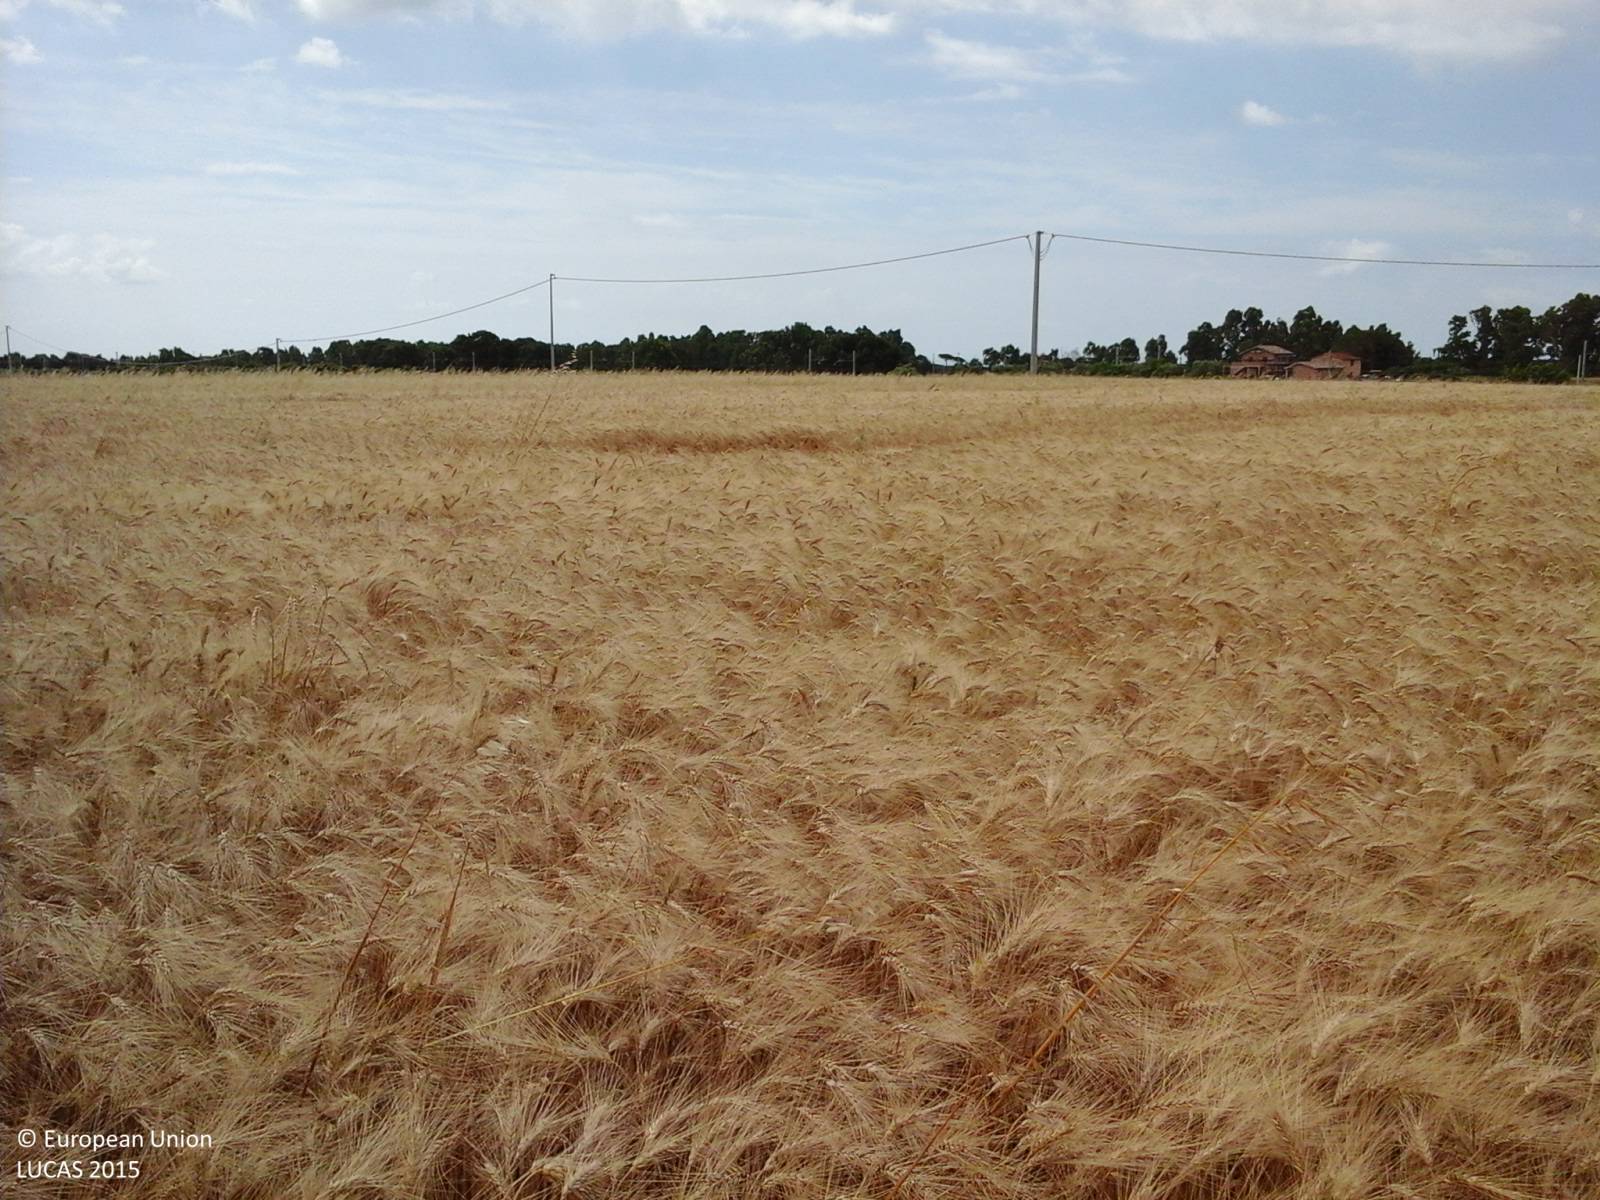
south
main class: Cropland
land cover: Durum wheat
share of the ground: > 75 %
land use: Agriculture (excluding fallow land and kitchen gardens)
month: June
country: IT
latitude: 42.2972
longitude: 11.6558
